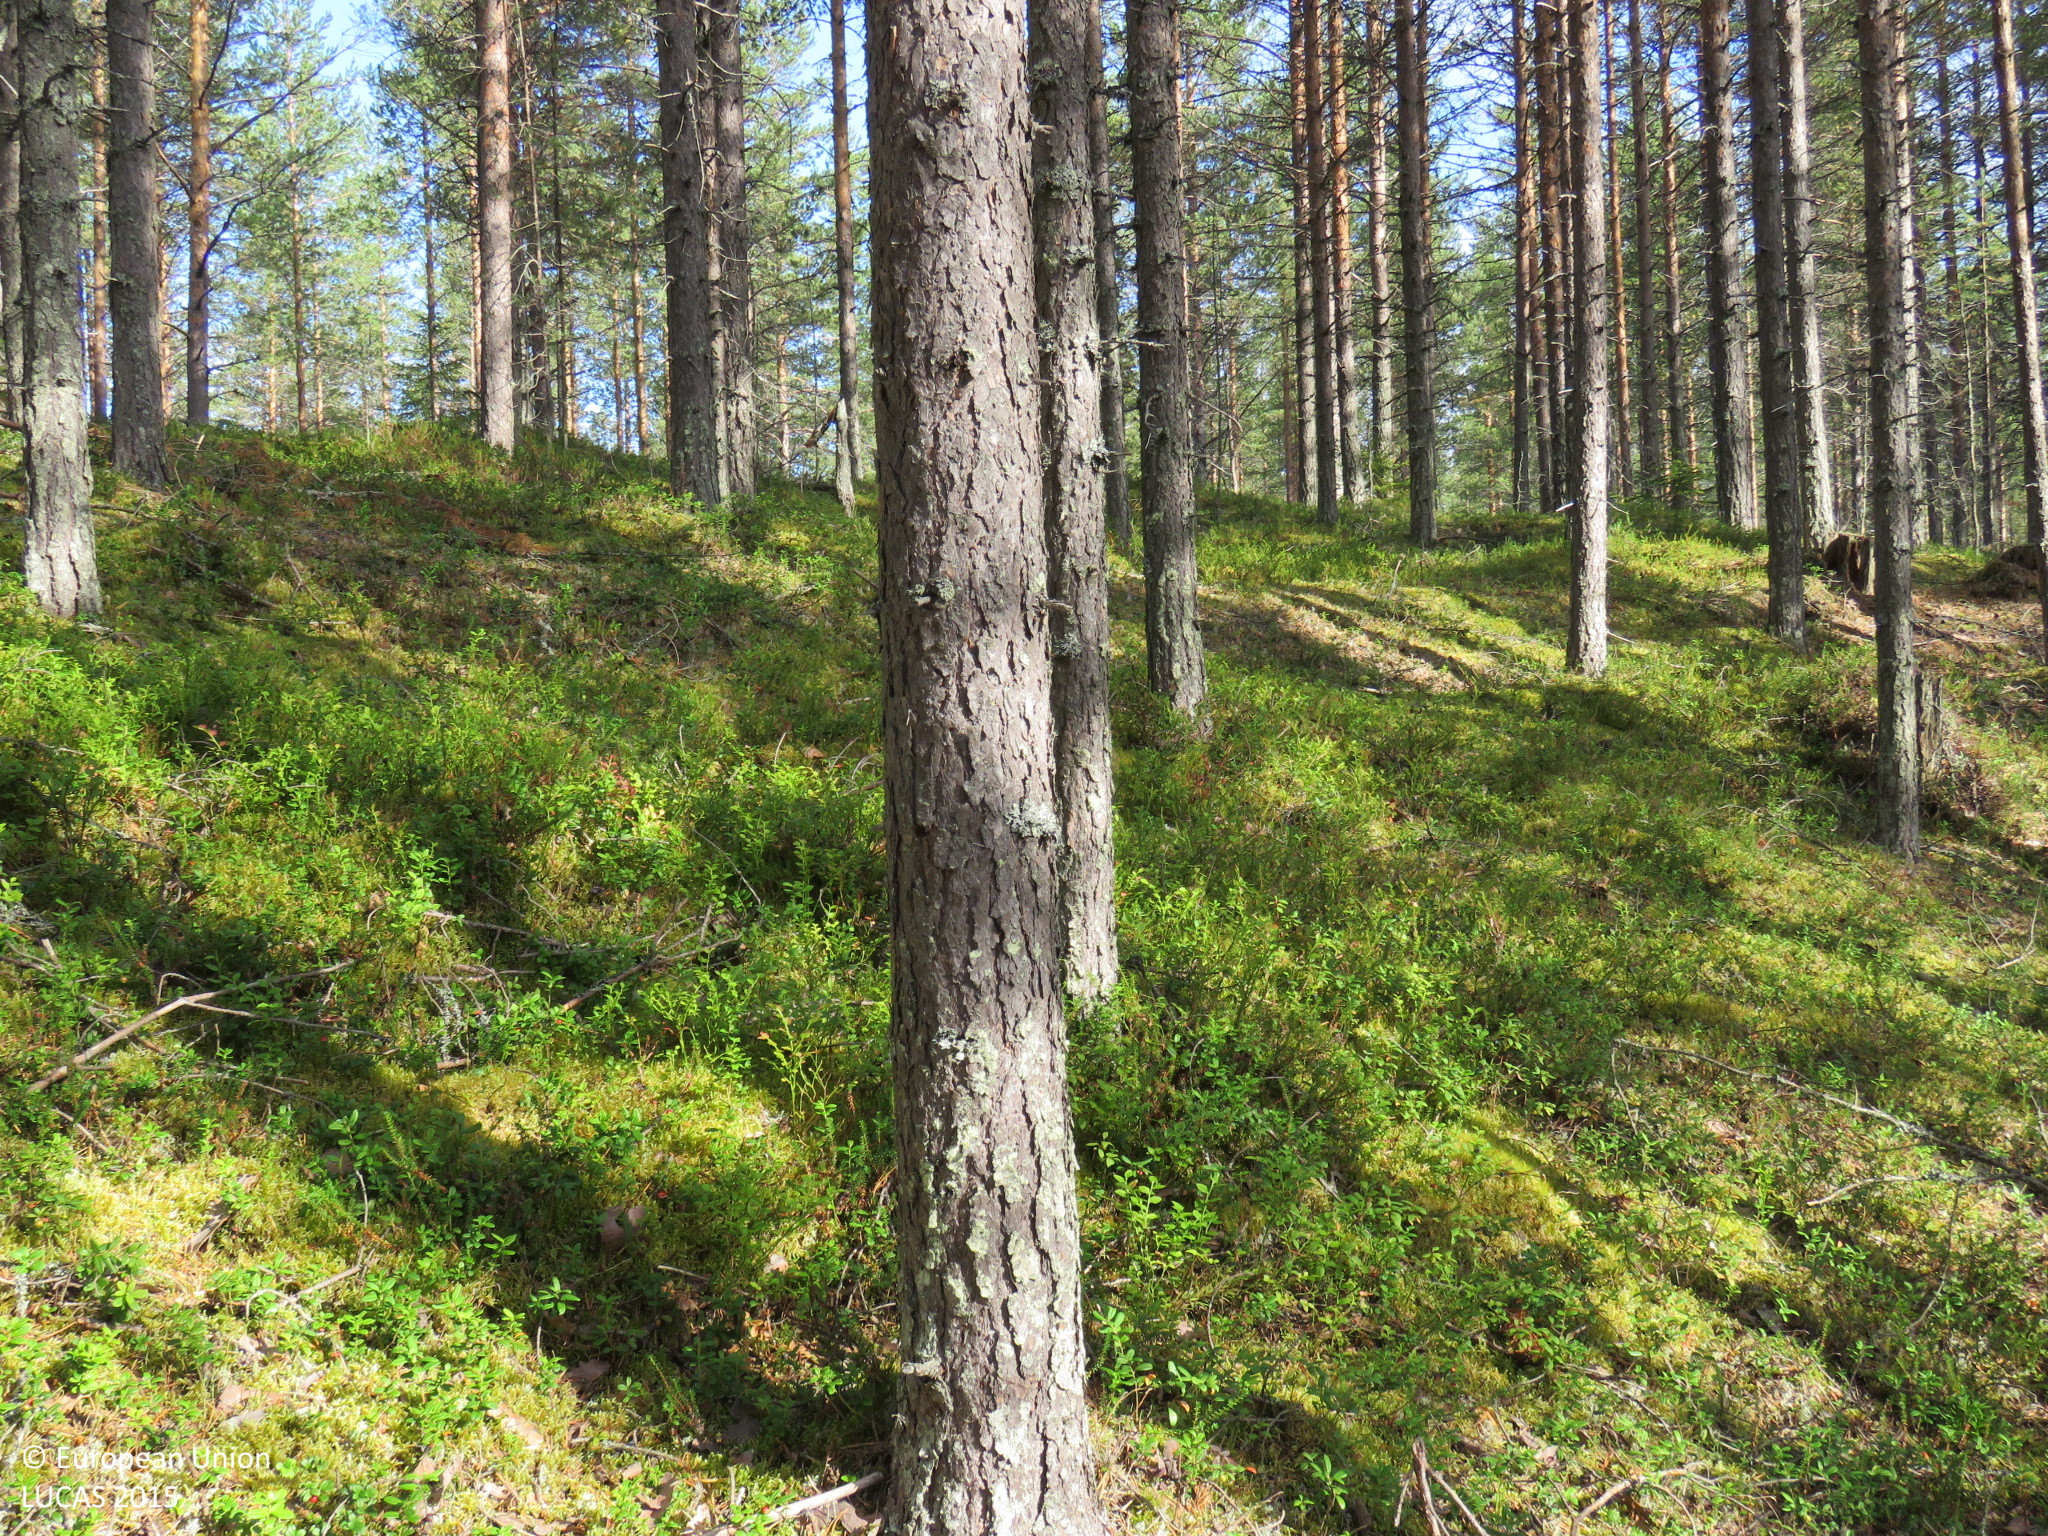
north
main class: Woodland
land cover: Pine dominated coniferous woodland
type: boreal forest
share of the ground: > 75 %
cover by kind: coniferous forest trees 80 %, shrubs 15 %, lichens and mosses 5 %
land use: Forestry
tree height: > 5 m
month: September
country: FI
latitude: 65.4352
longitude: 27.5727
